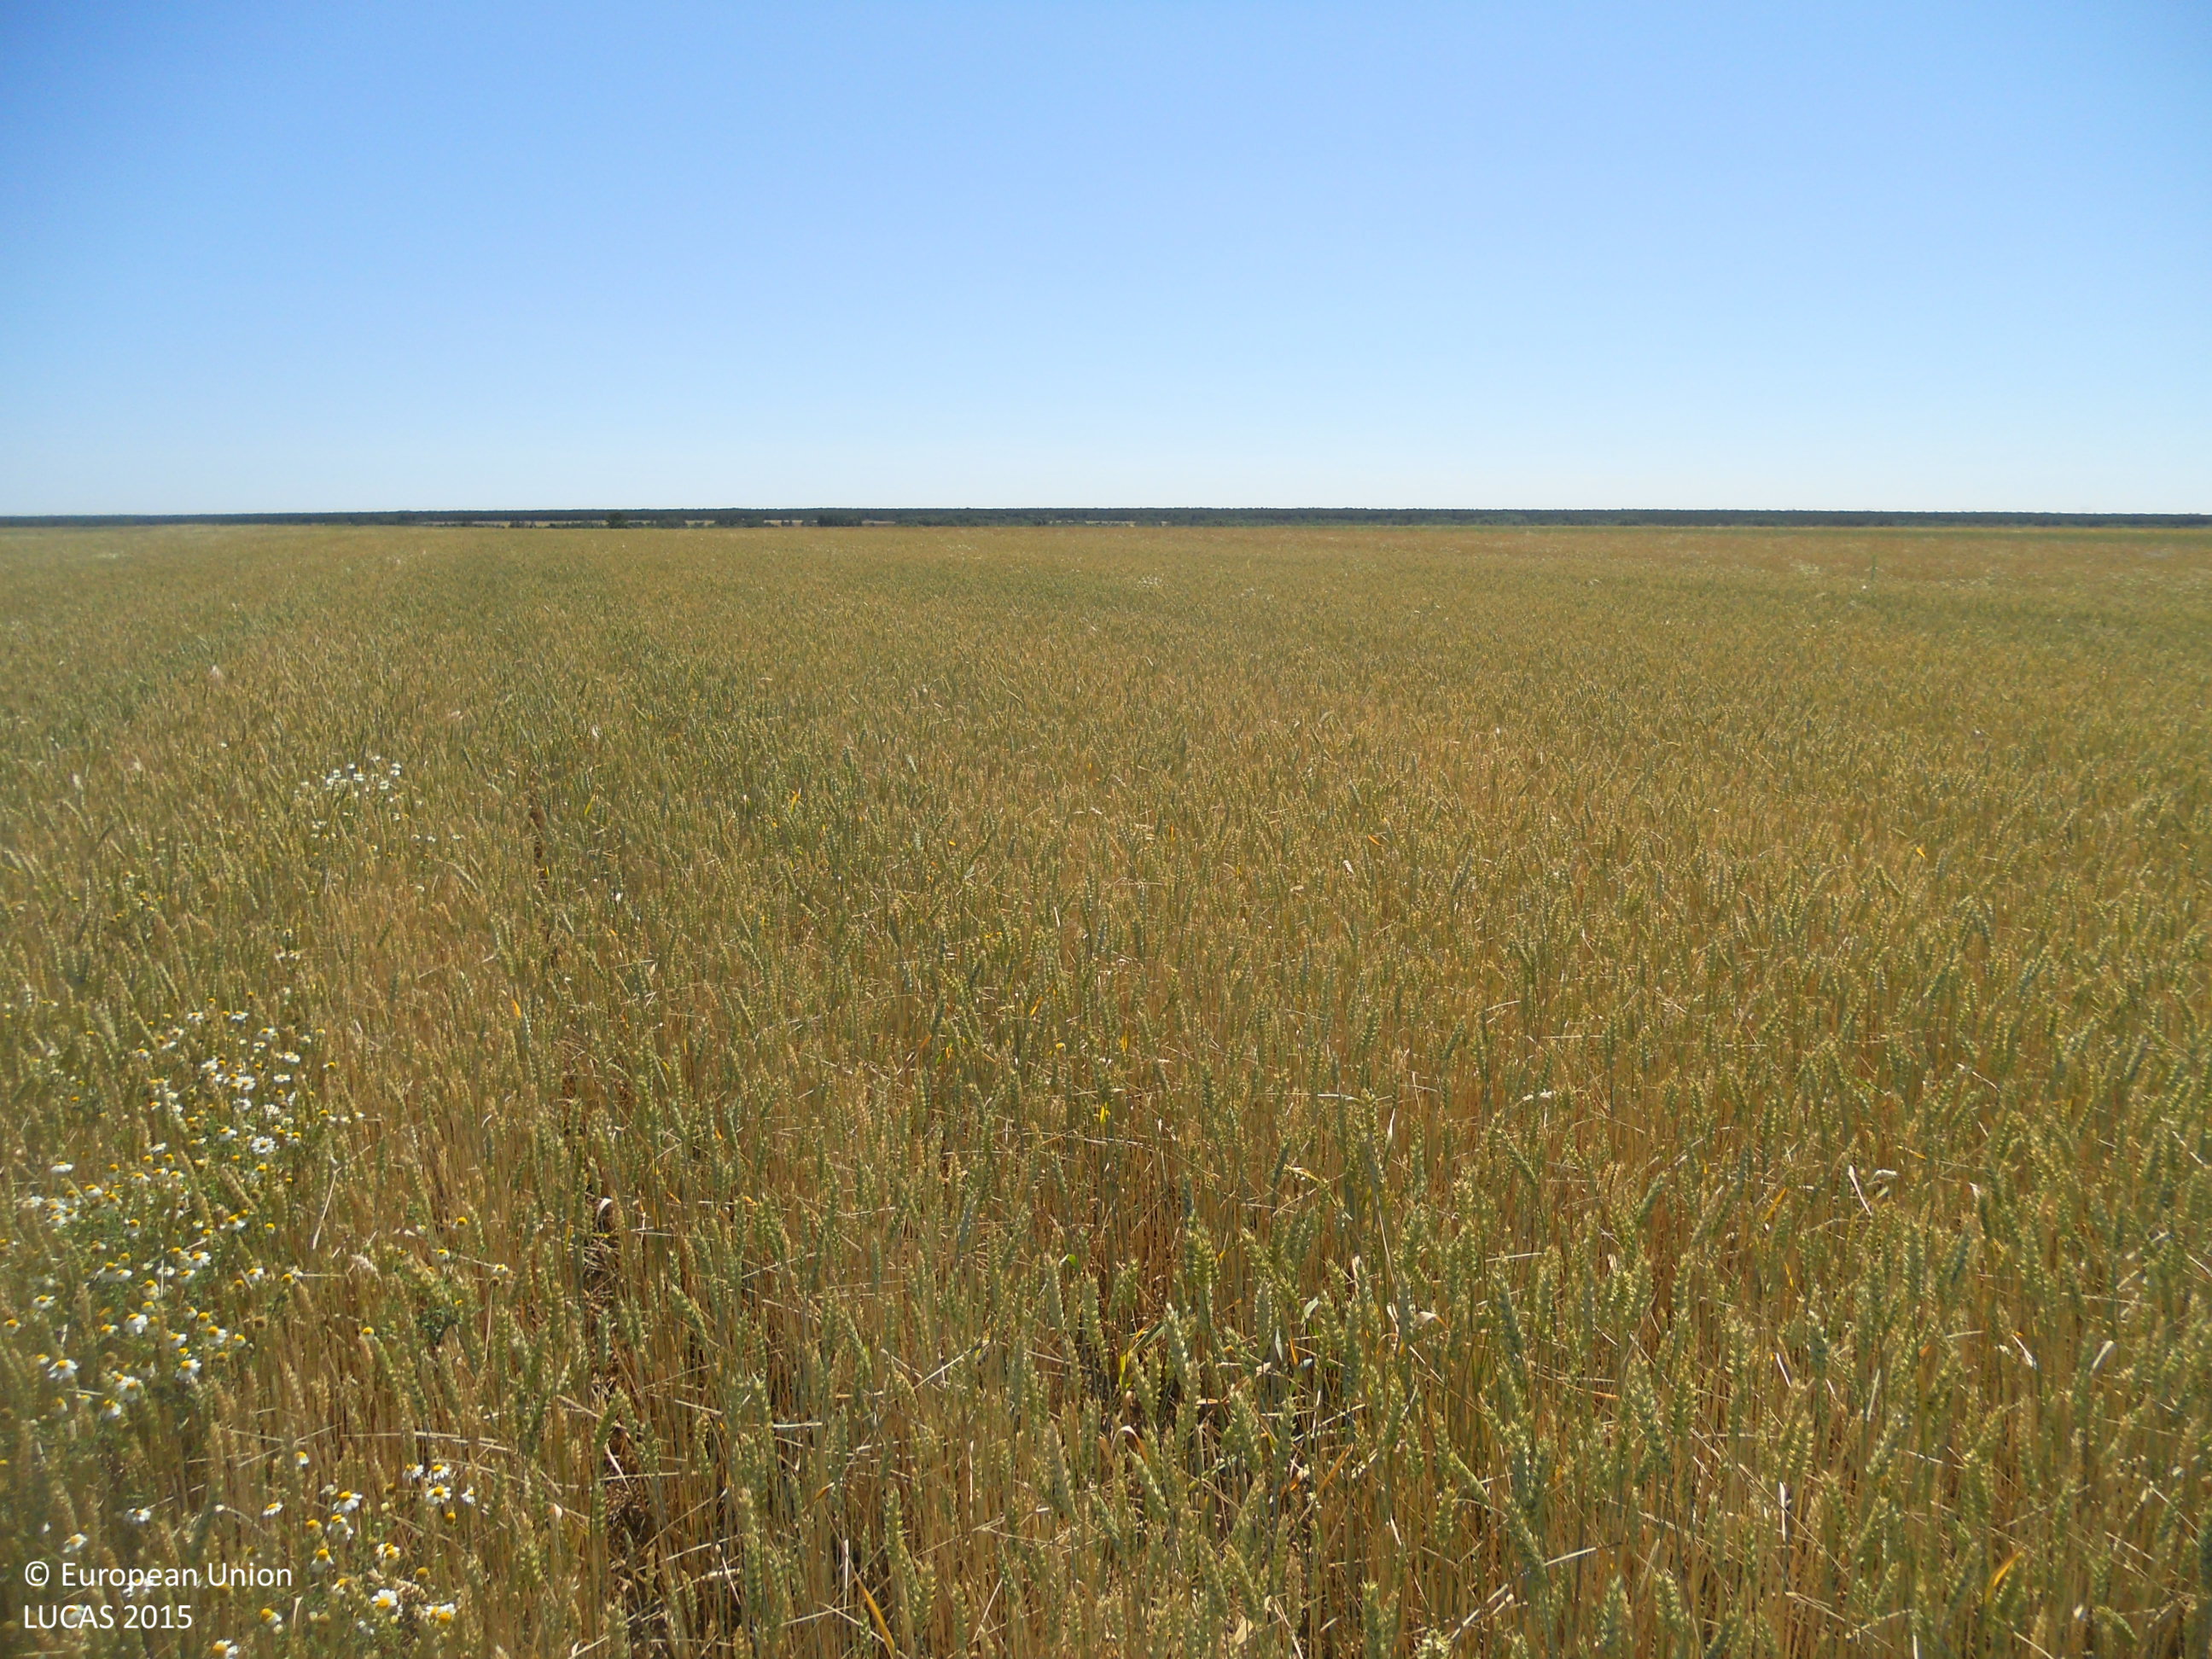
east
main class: Cropland
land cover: Common wheat
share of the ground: > 75 %
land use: Agriculture (excluding fallow land and kitchen gardens)
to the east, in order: Common wheat
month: June
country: ES
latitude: 42.4605
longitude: -4.9064
